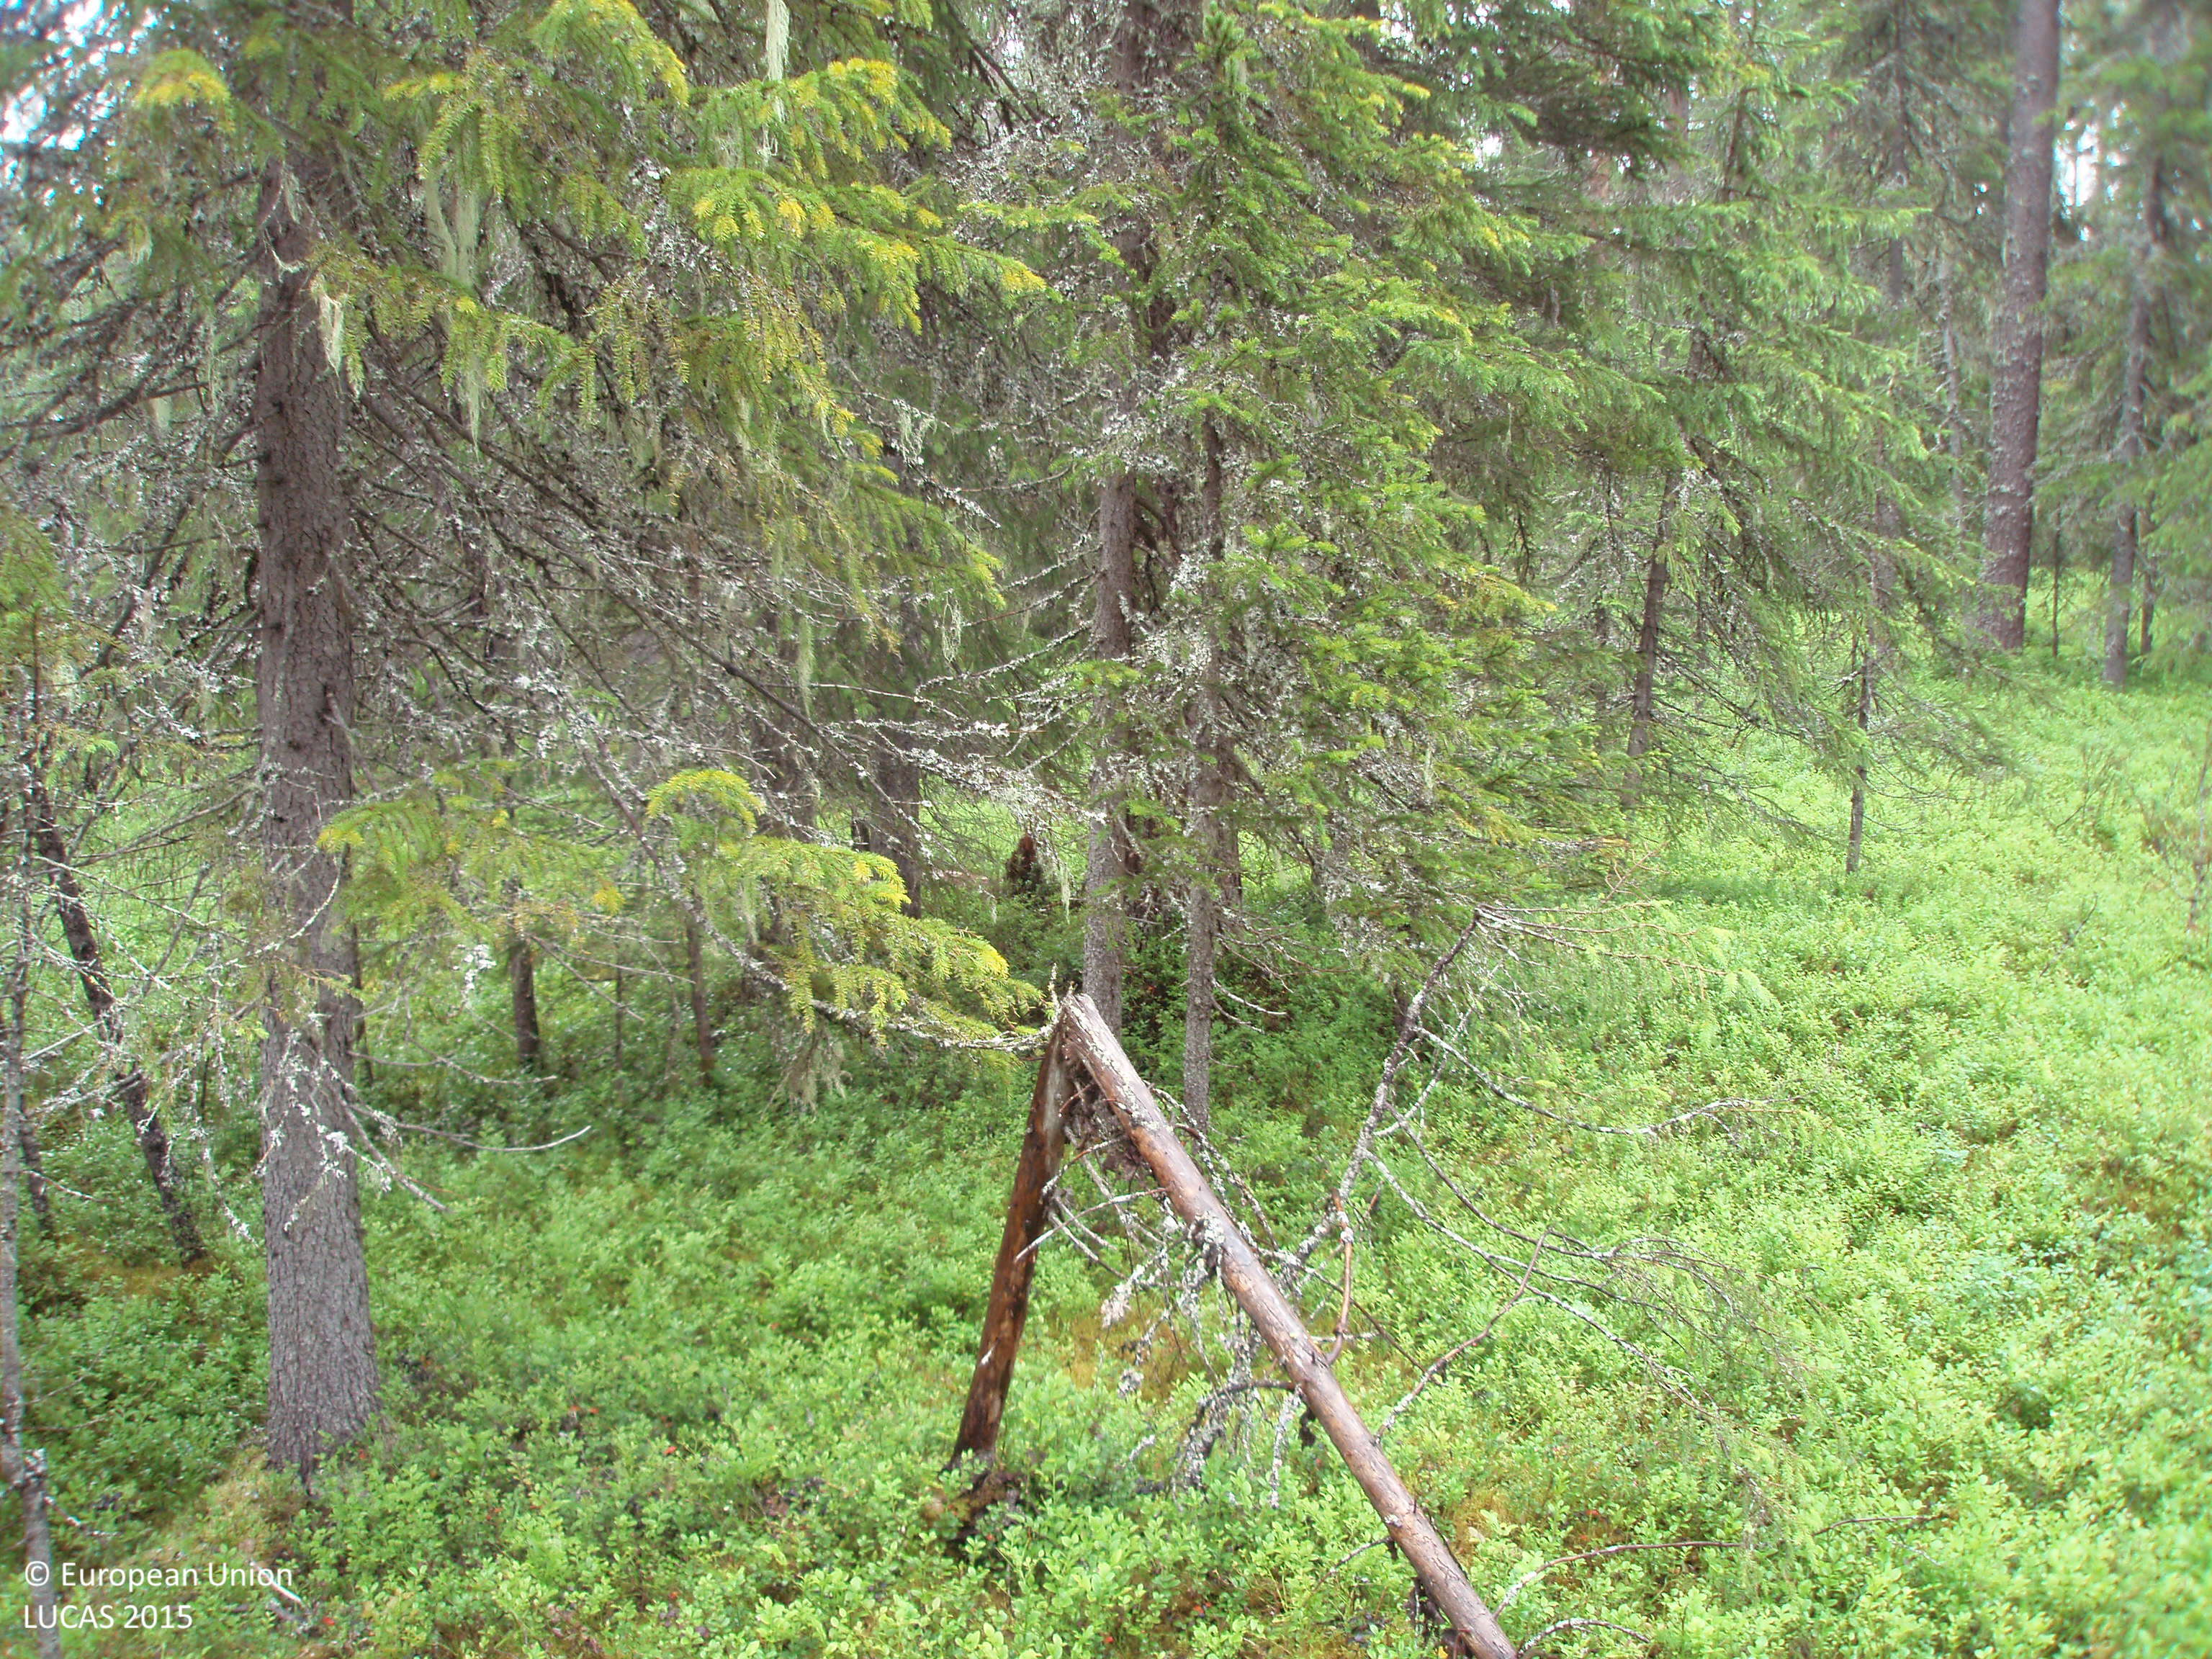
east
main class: Woodland
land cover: Spruce dominated coniferous woodland
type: boreal forest
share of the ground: > 75 %
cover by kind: coniferous forest trees 75 %, shrubs 25 %
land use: Forestry
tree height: > 5 m
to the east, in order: Spruce dominated coniferous woodland; Ditches and canals; Paved roads, cycling and walking lanes; Ditches and canals; Spruce dominated coniferous woodland; Pine dominated coniferous woodland; Peatbogs; Spruce dominated coniferous woodland
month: August
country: FI
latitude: 65.6226
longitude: 27.5651
